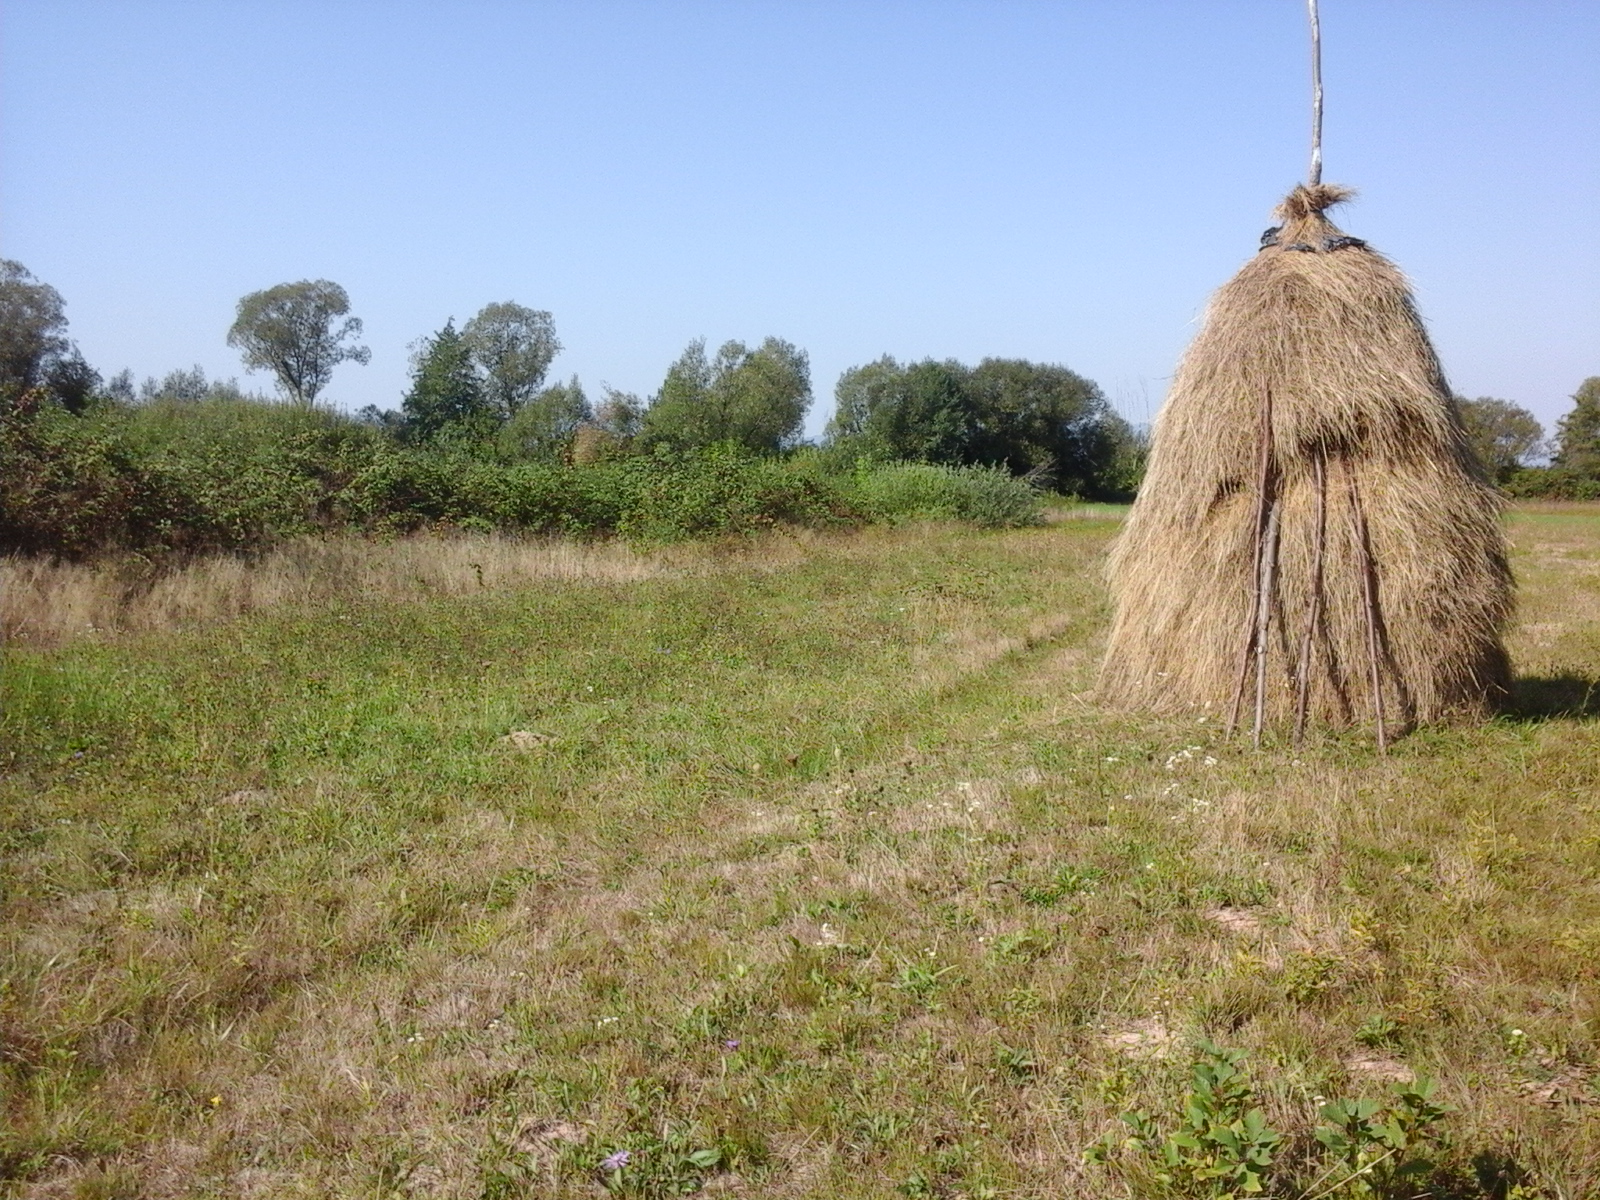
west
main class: Grassland
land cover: Grassland without tree/shrub cover
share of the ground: > 75 %
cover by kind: herbaceous plants 100 %
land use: Agriculture (excluding fallow land and kitchen gardens)
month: September
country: RO
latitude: 46.5961
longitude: 22.5181
